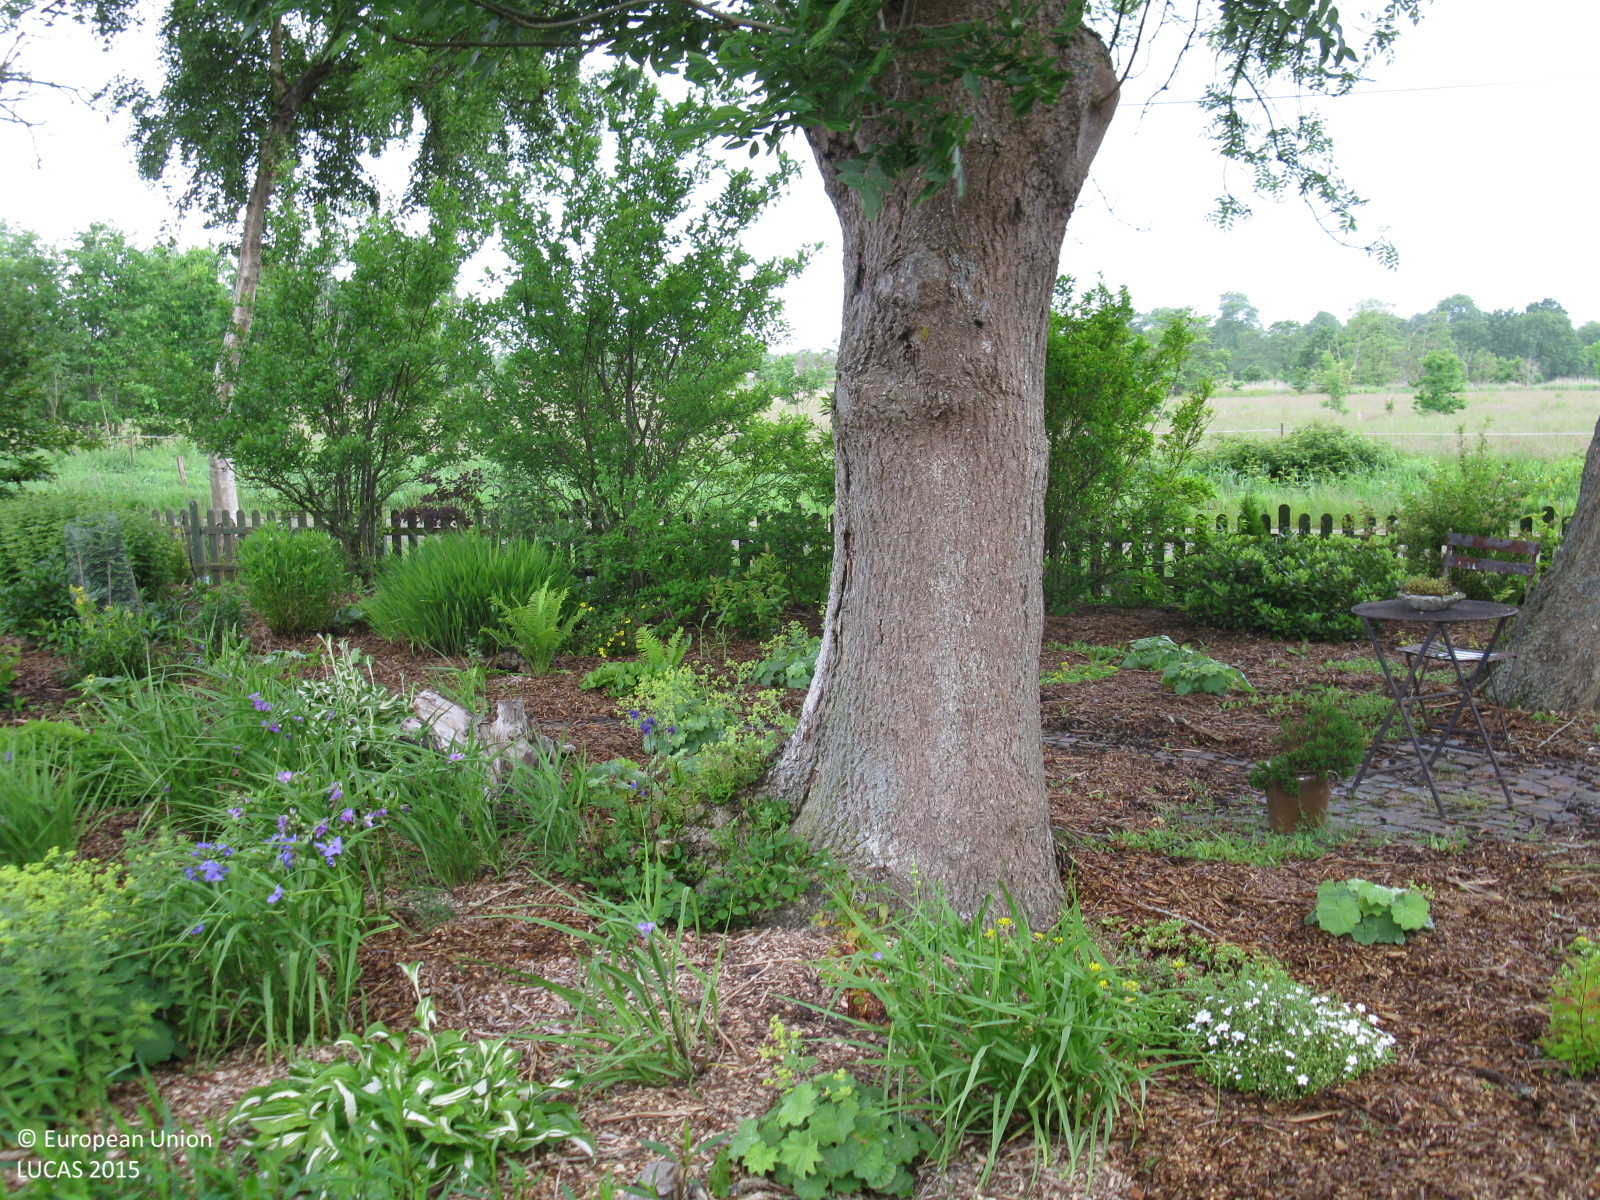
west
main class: Cropland
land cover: Floriculture and ornamental plants
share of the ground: > 75 %
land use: Residential
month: June
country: DE
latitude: 53.5171
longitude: 7.3614
